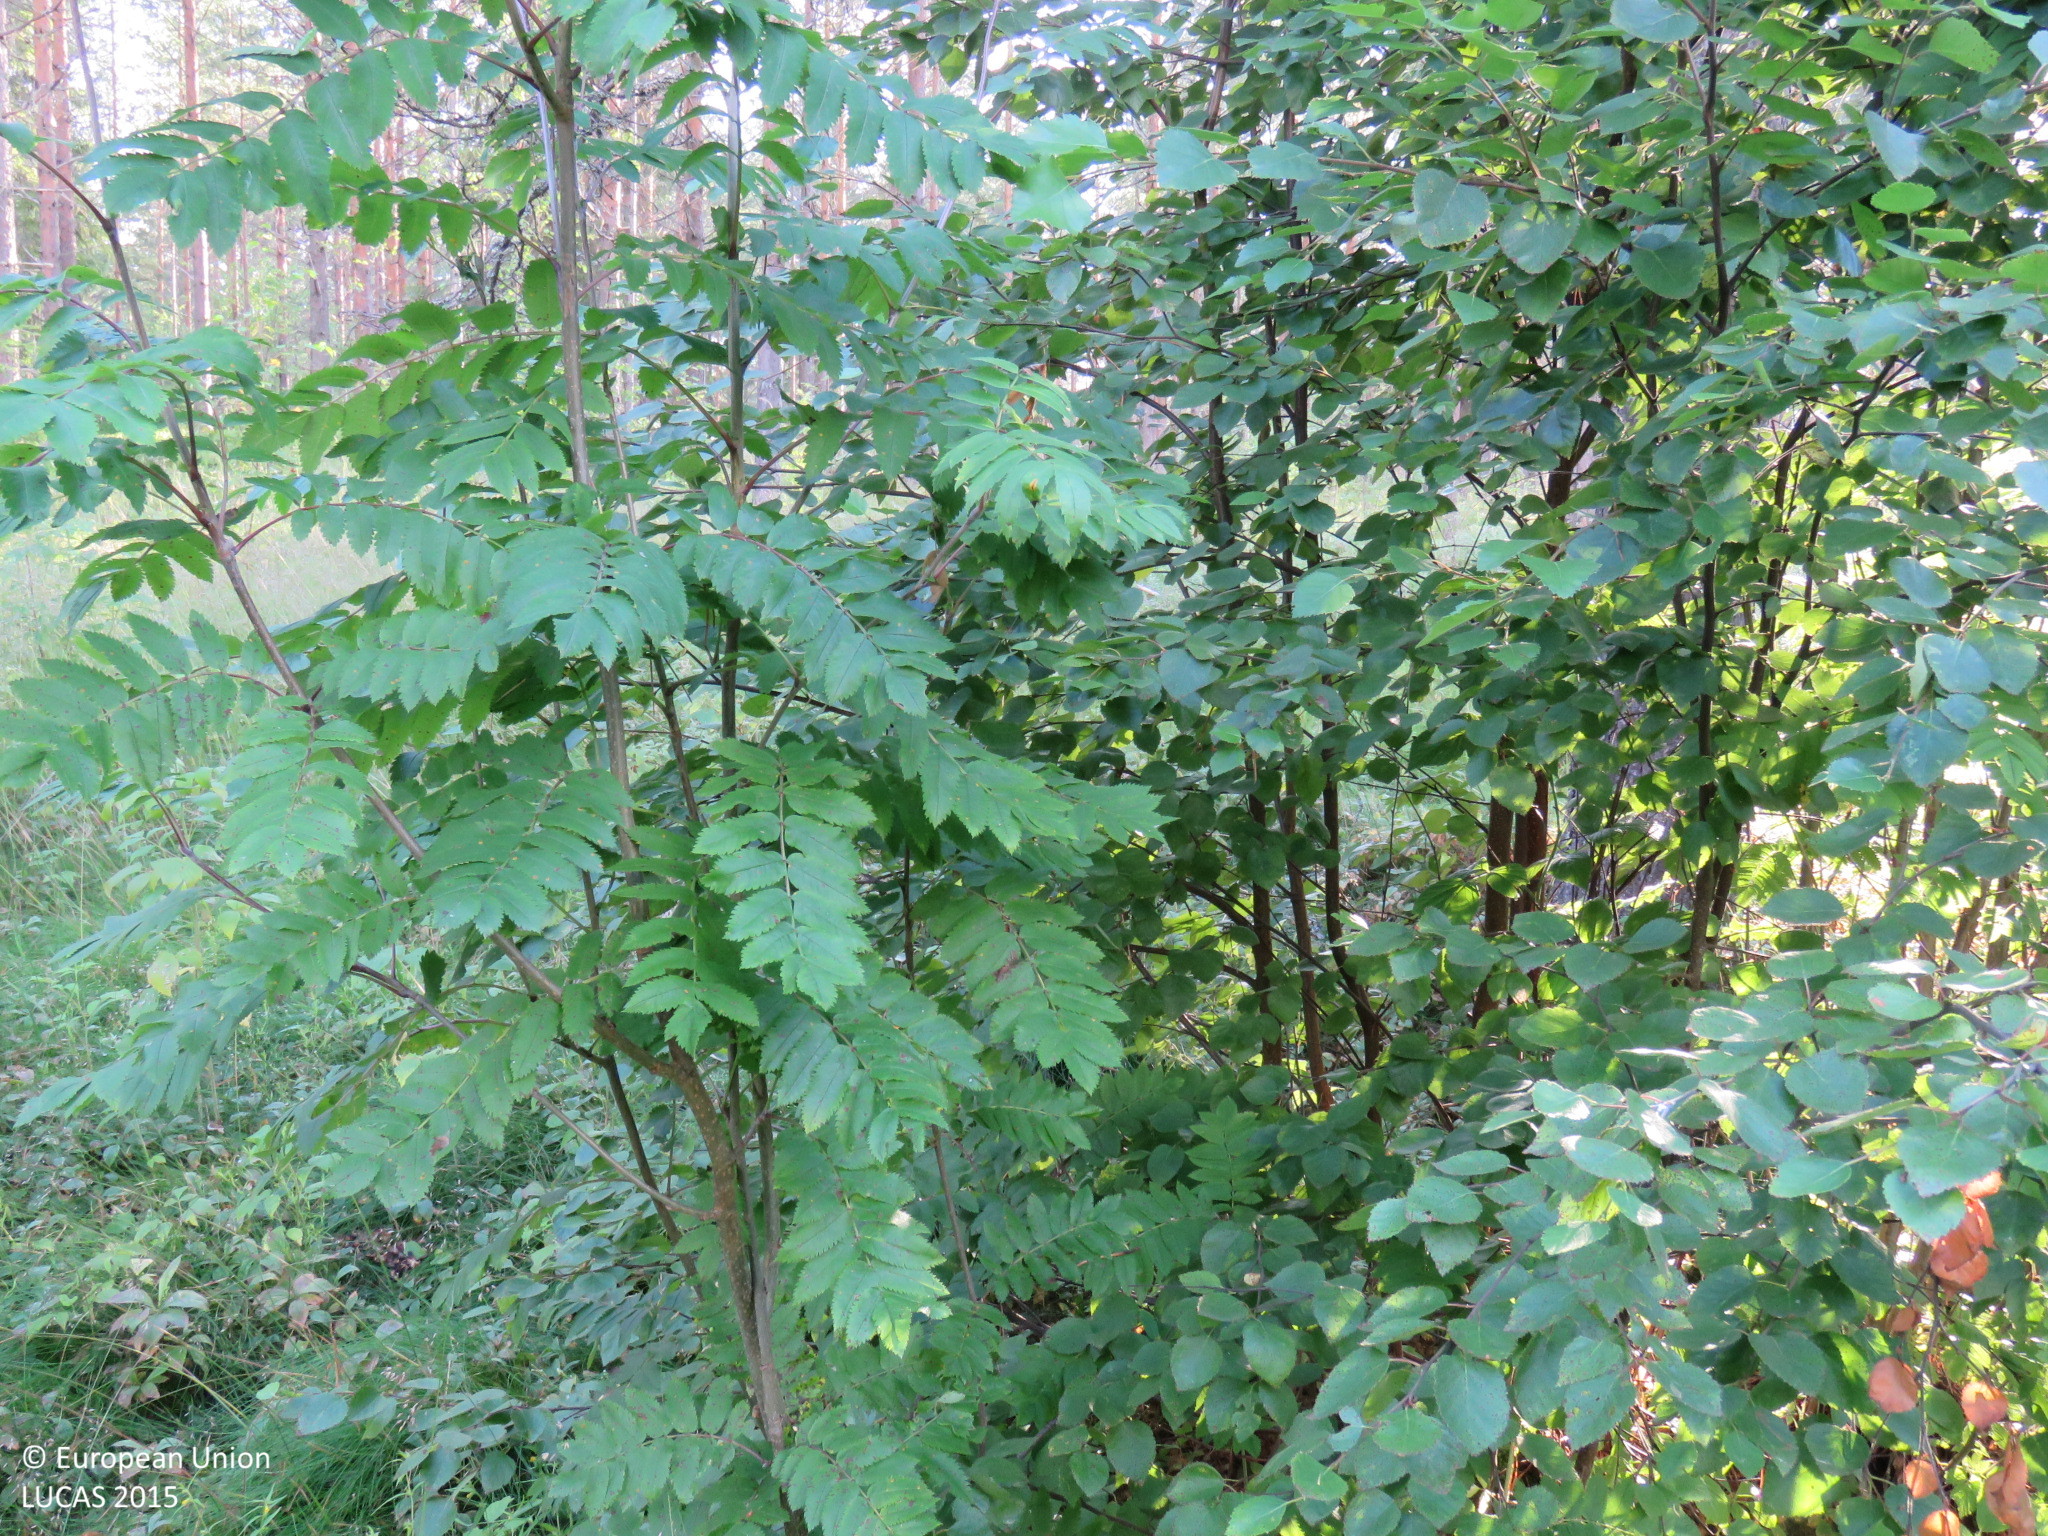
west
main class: Woodland
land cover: Other mixed woodland
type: boreal forest
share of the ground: > 75 %
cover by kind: coniferous forest trees 40 %, broadleaved forest trees 40 %, shrubs 10 %, herbaceous plants 10 %
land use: Forestry
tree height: > 5 m
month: July
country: FI
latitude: 64.8786
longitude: 25.7771
